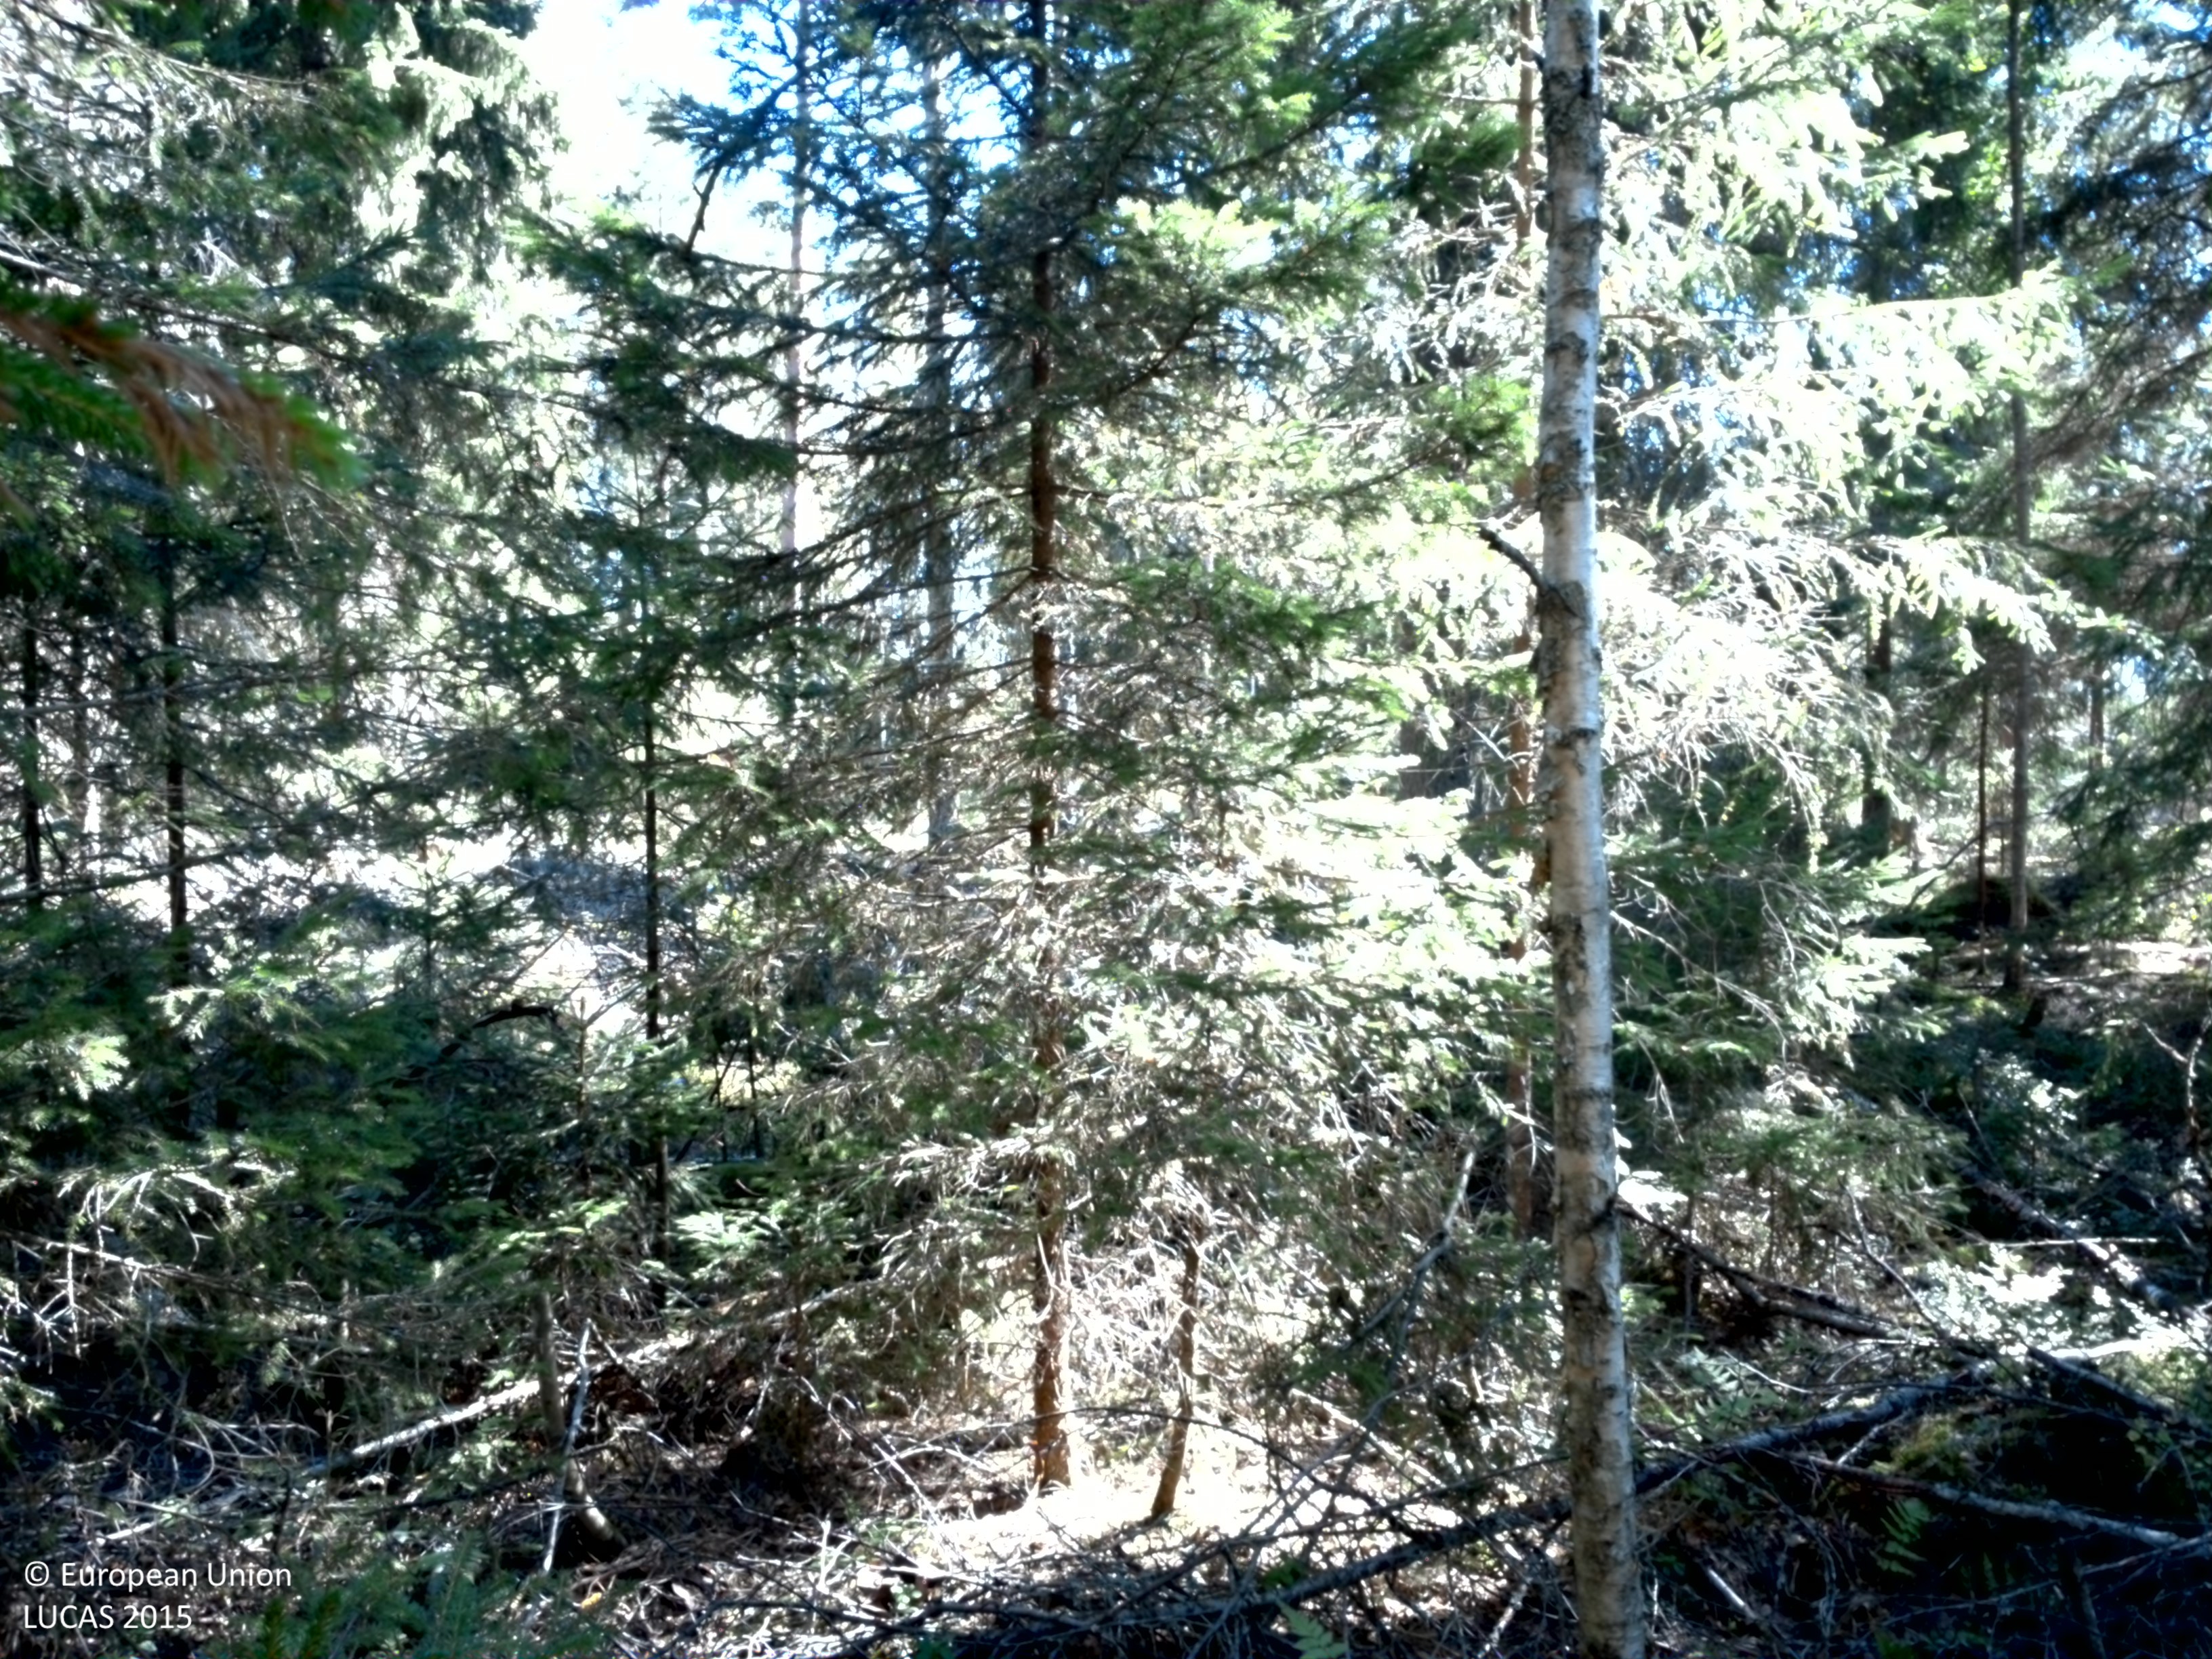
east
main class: Woodland
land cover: Other coniferous woodland
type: boreal forest
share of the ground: > 75 %
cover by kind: coniferous forest trees 85 %, broadleaved forest trees 10 %, herbaceous plants 5 %
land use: Forestry
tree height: > 5 m
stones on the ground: > 50 %
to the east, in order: Other coniferous woodland; Spruce dominated coniferous woodland; Other coniferous woodland; Spruce dominated coniferous woodland; Ditches and canals; Other leguminous and mixtures for fodder; Electric lines; Other leguminous and mixtures for fodder
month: August
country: SE
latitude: 60.0943
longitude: 17.0581
